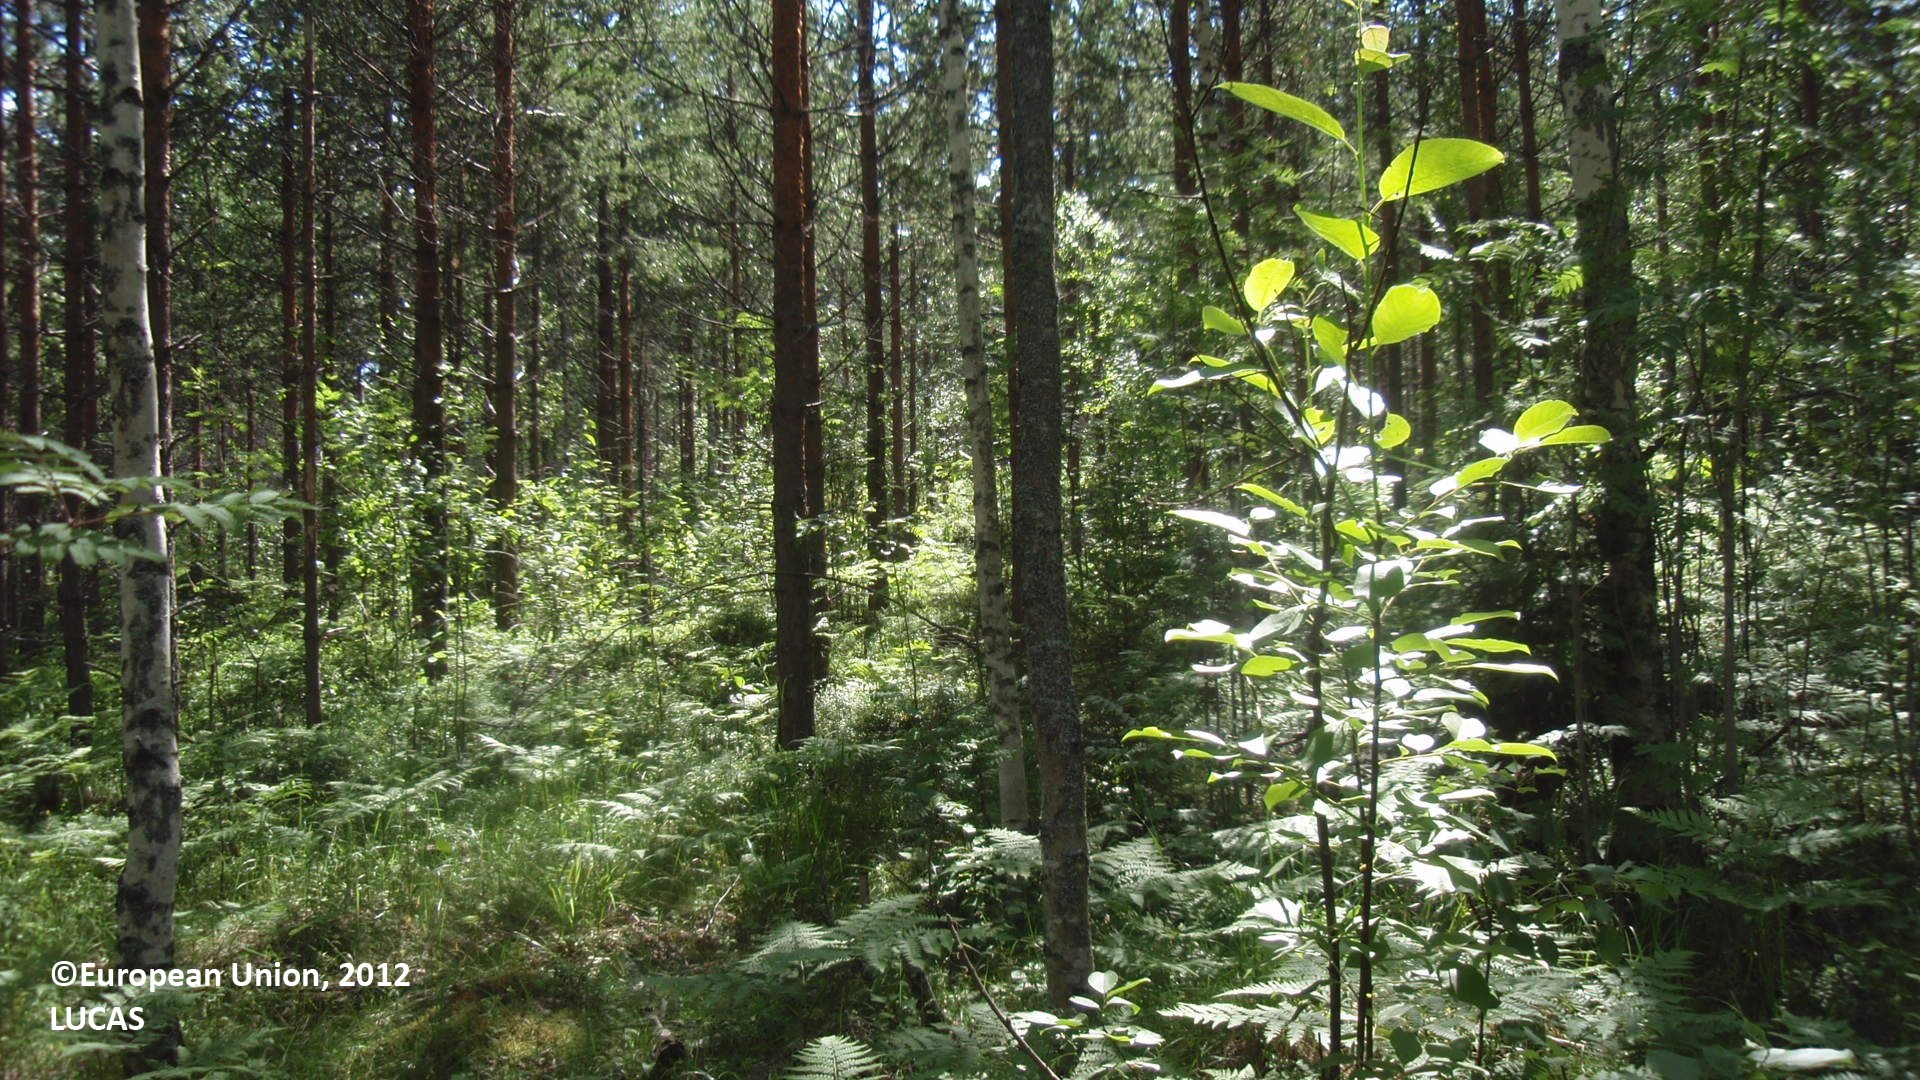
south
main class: Woodland
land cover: Other mixed woodland
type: boreal forest
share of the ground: > 75 %
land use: Forestry
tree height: > 5 m
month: July
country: FI
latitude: 61.7327
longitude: 28.3173
